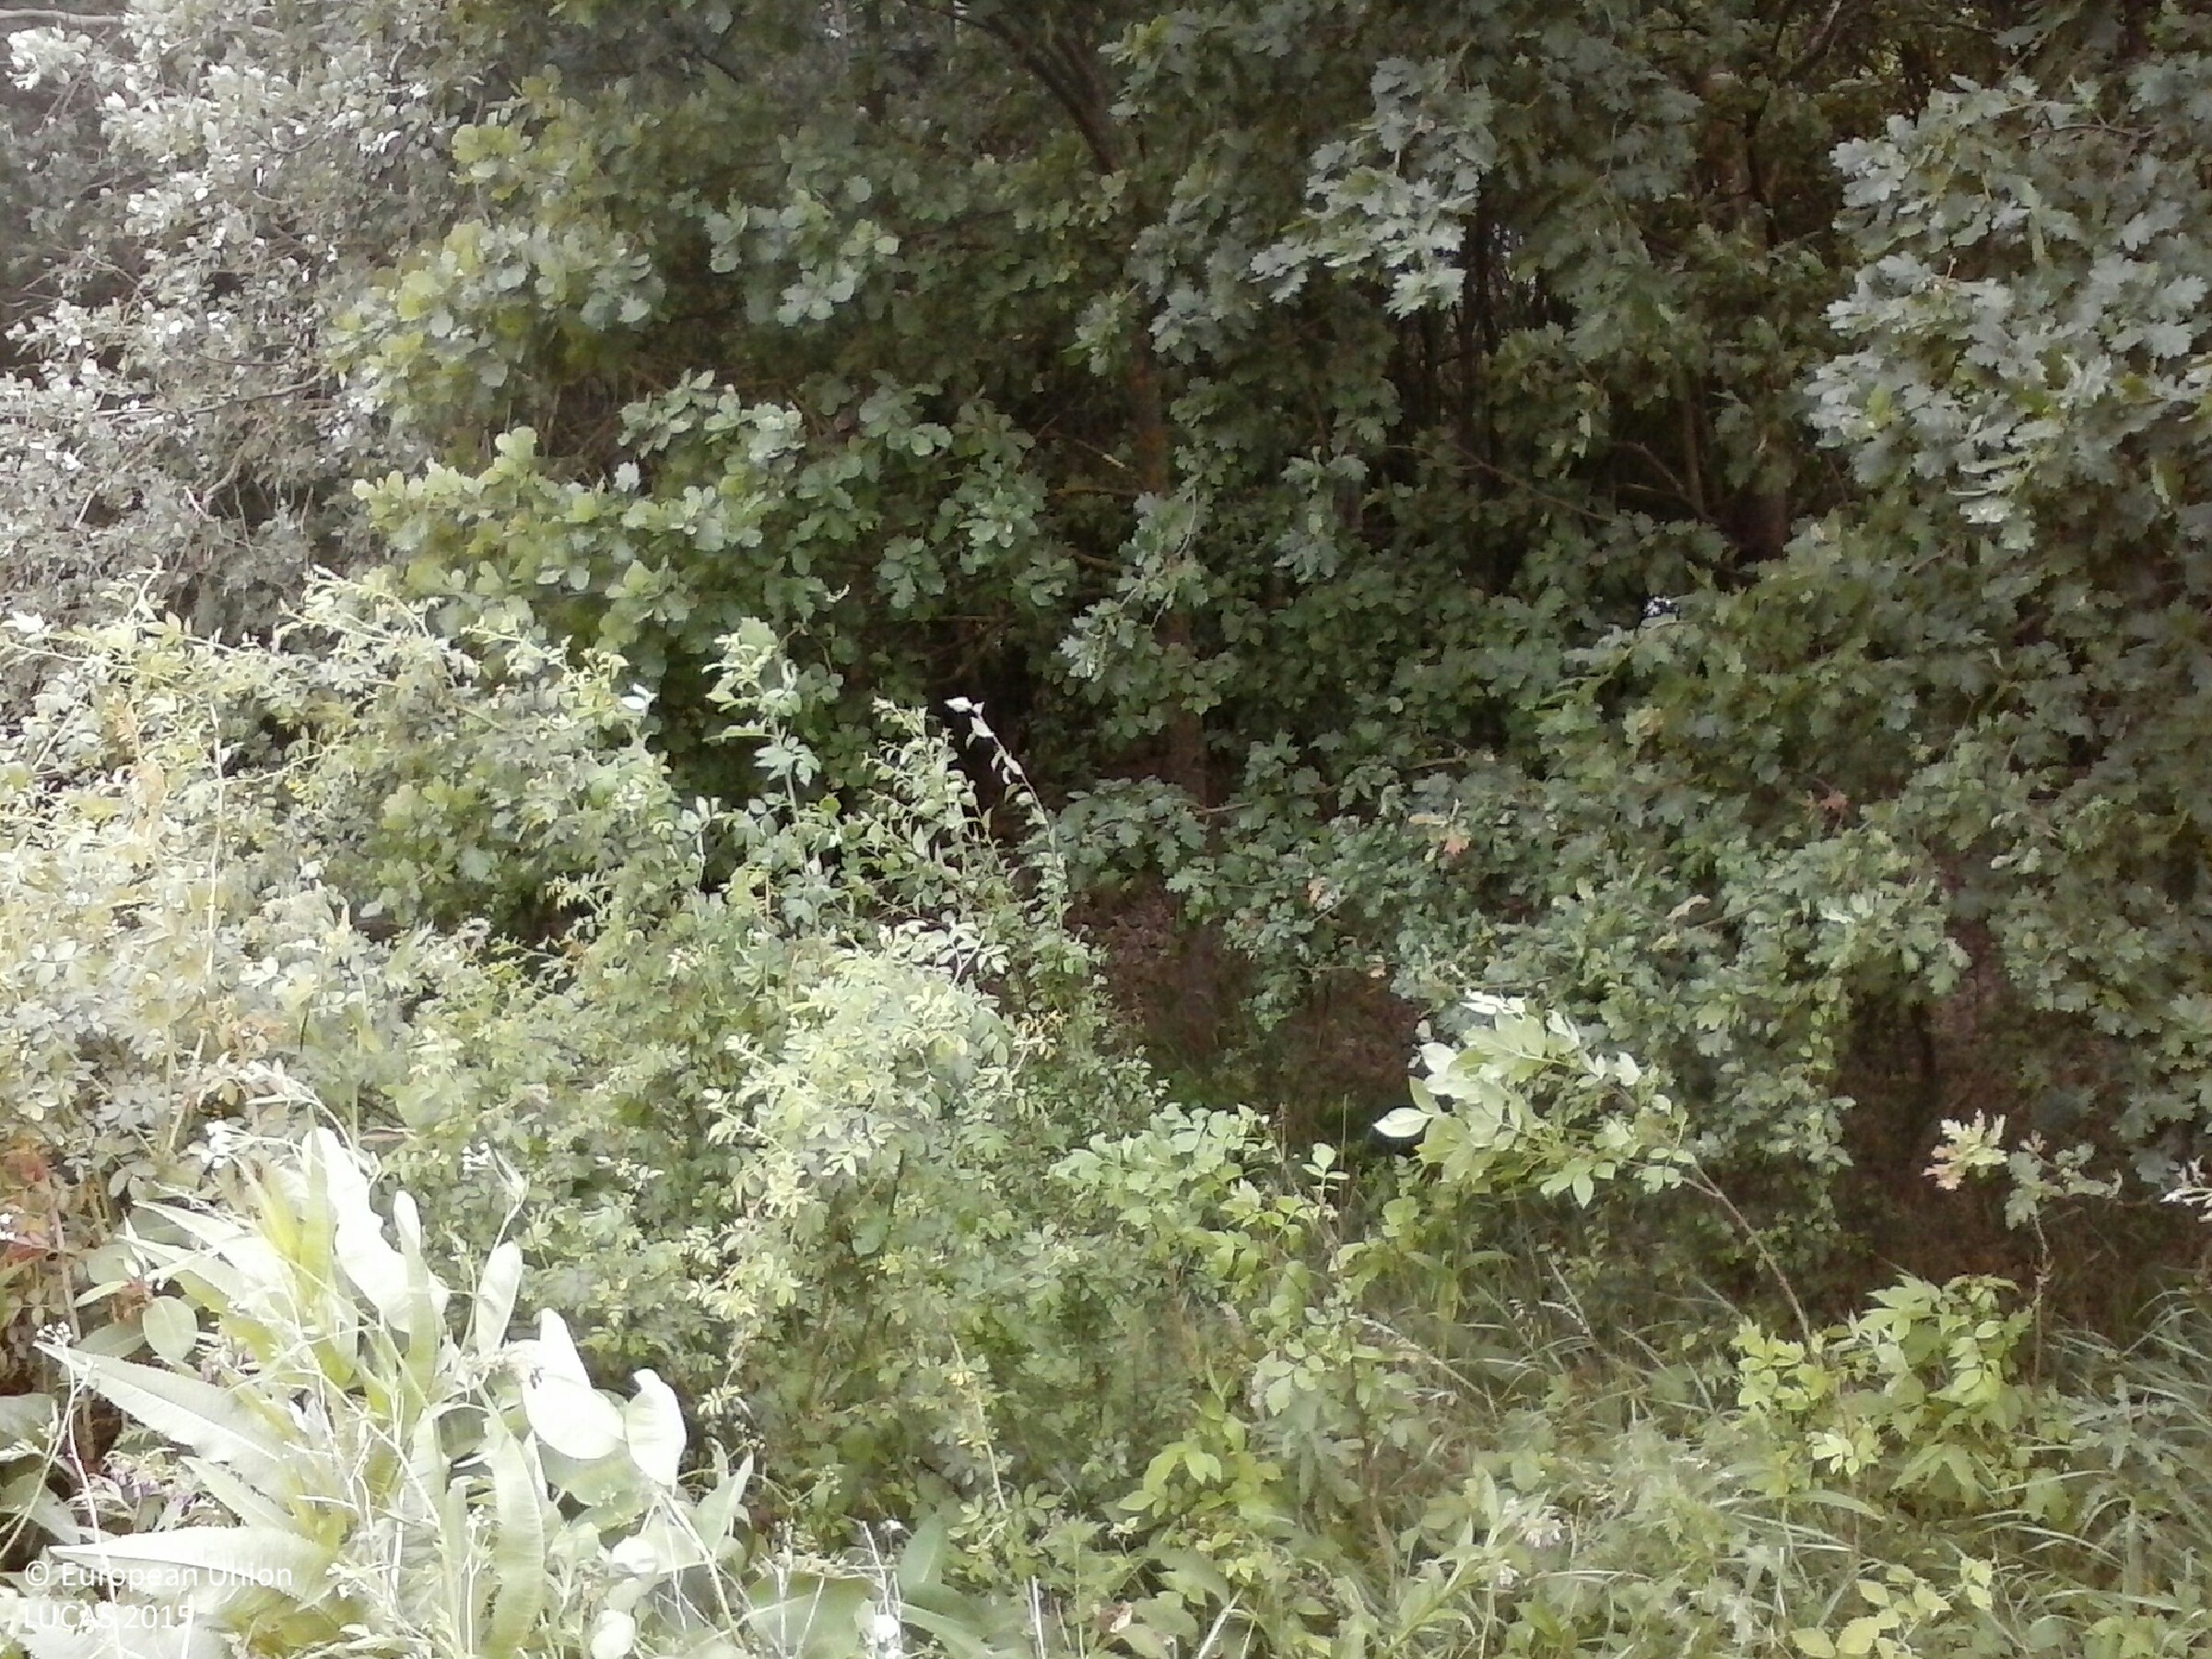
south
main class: Grassland
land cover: Spontaneously vegetated surfaces
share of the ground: > 75 %
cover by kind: herbaceous plants 100 %
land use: Water supply and treatment
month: June
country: HU
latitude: 46.1848
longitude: 20.2445
